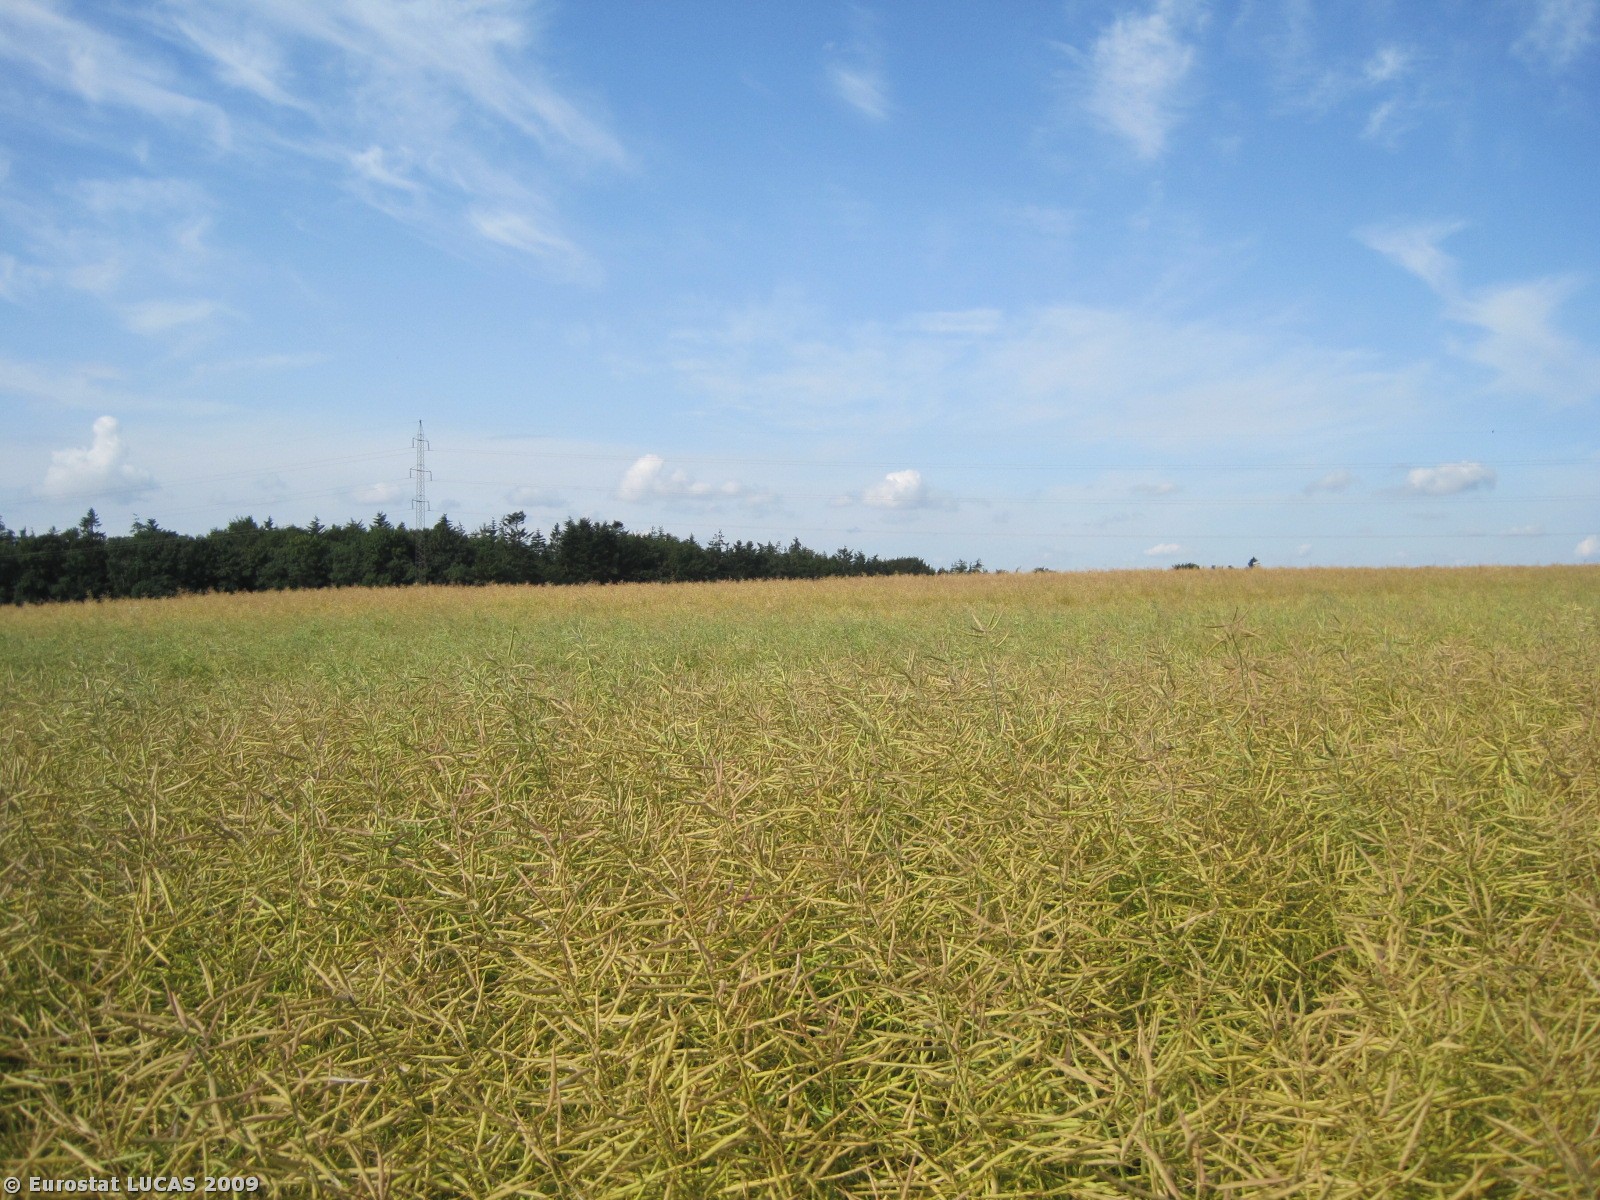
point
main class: Cropland
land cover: Rape and turnip rape
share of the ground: > 75 %
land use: Agriculture (excluding fallow land and kitchen gardens)
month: July
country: DK
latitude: 56.6190
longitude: 9.7884
